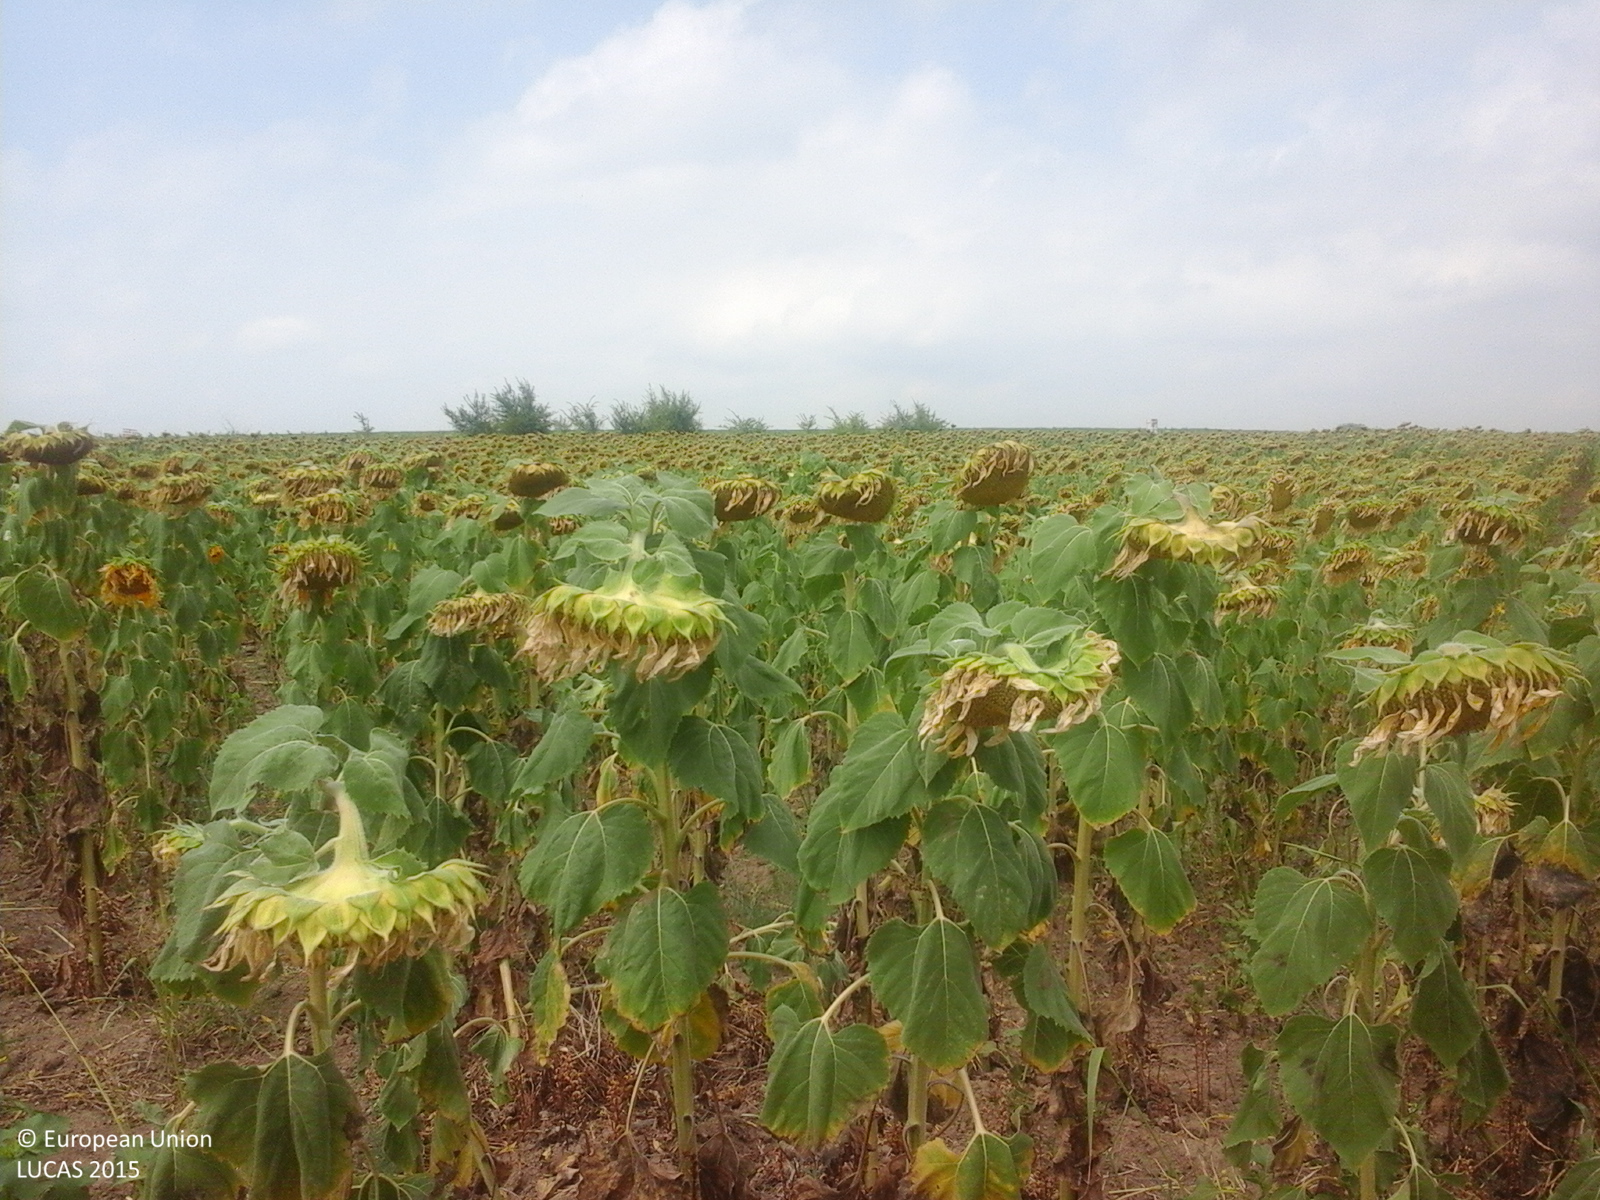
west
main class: Cropland
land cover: Sunflower
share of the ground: > 75 %
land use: Agriculture (excluding fallow land and kitchen gardens)
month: July
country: RO
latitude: 45.1995
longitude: 28.1847
